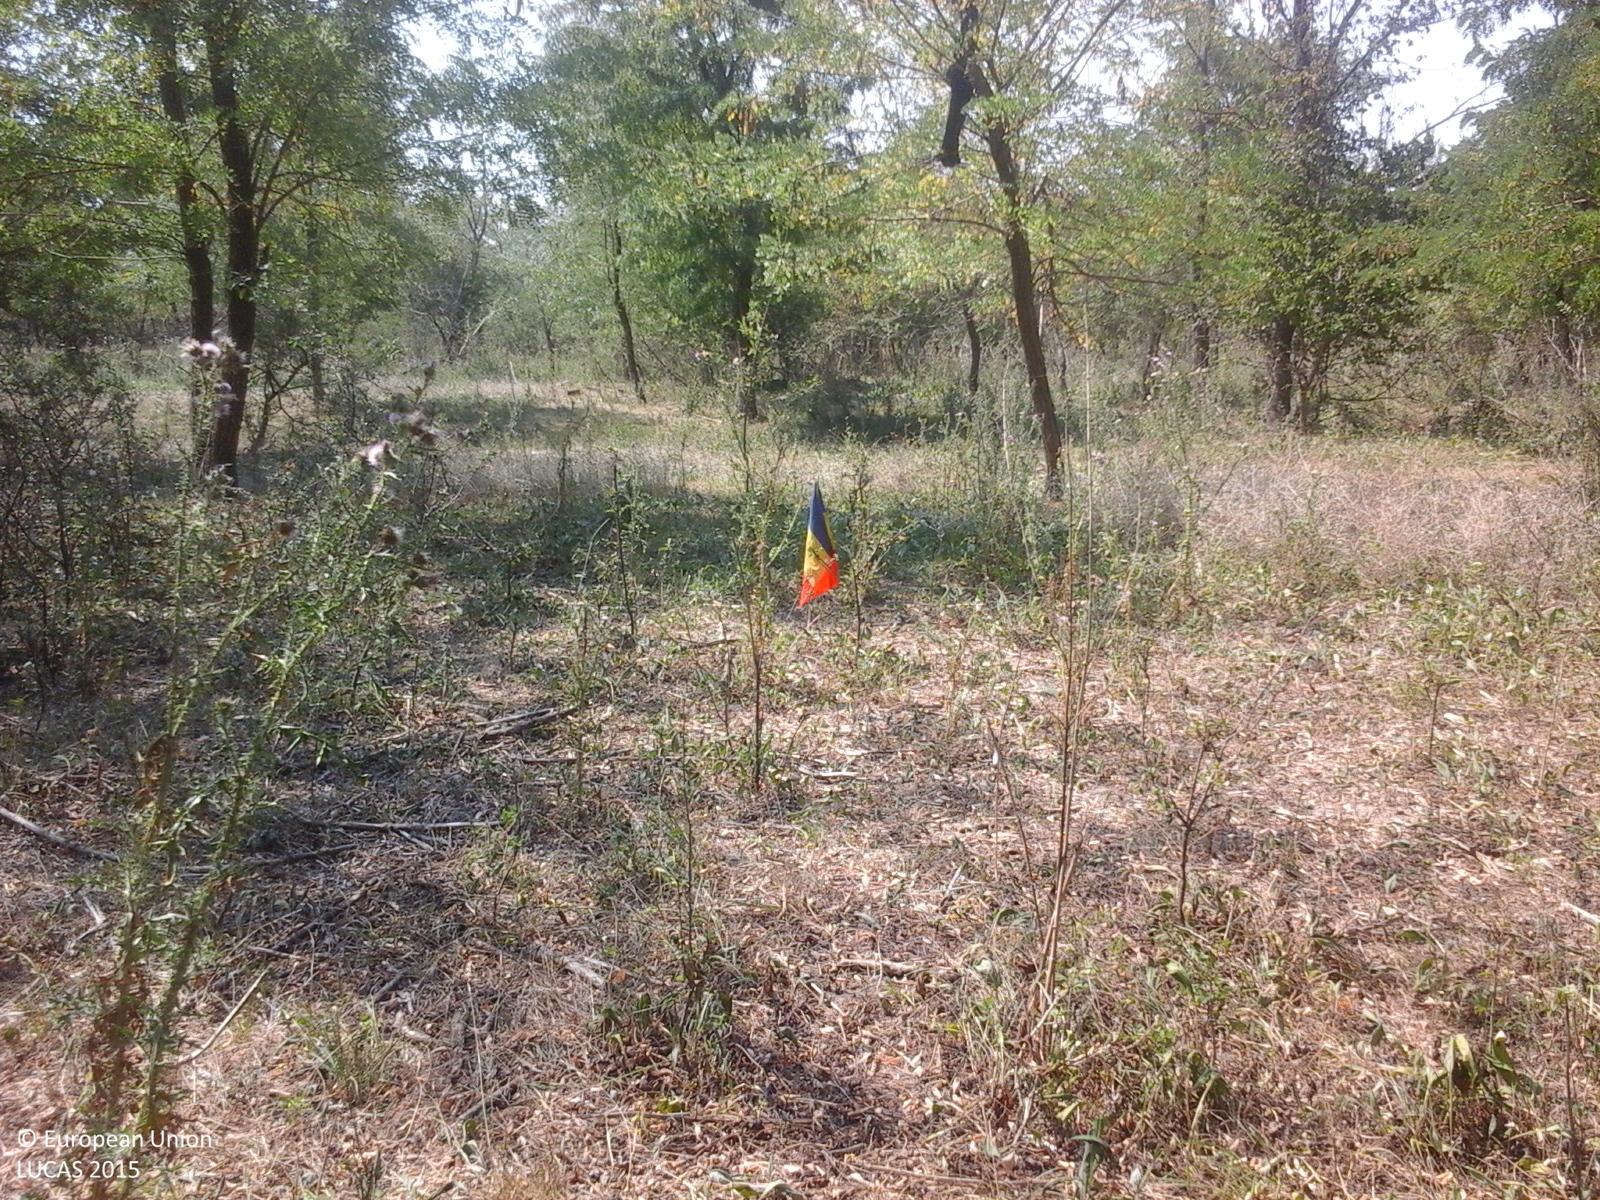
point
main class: Woodland
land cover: Broadleaved woodland
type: broadleaved evergreen forest
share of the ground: > 75 %
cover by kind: broadleaved forest trees 100 %
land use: Forestry
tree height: > 5 m
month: August
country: RO
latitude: 45.7238
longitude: 27.3823
